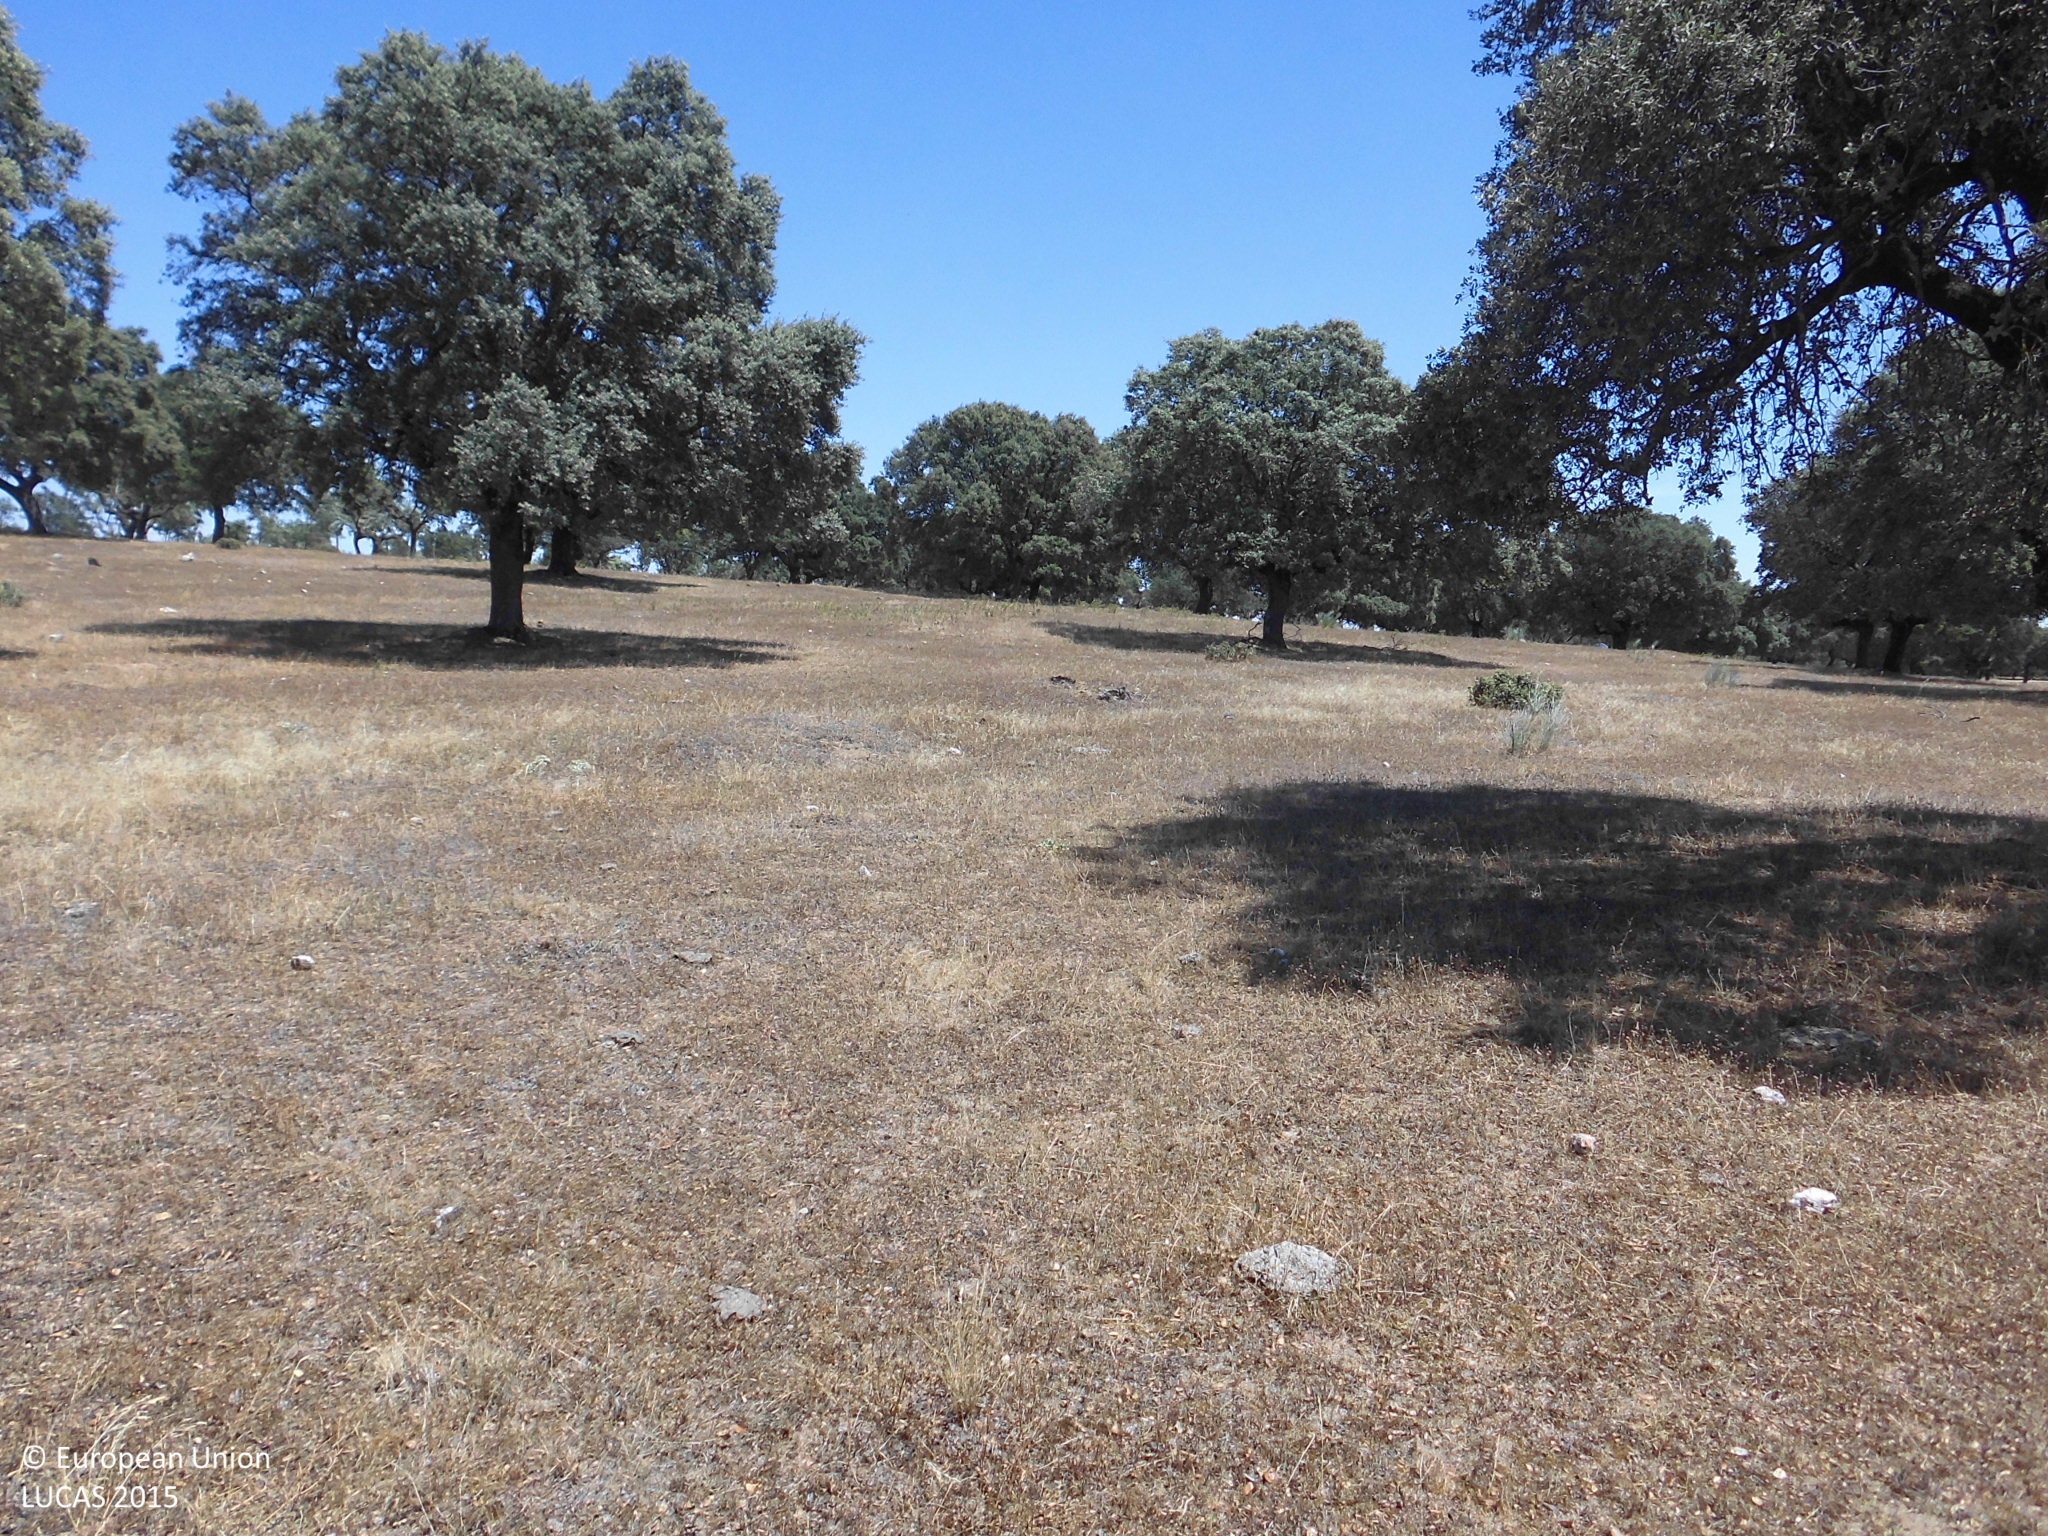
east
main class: Woodland
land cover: Broadleaved woodland
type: broadleaved evergreen forest
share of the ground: 10 - 25 %
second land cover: Grassland without tree/shrub cover
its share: > 75 %
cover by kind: herbaceous plants 80 %, broadleaved forest trees 20 %
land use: Forestry
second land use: Agriculture (excluding fallow land and kitchen gardens)
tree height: > 5 m
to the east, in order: Broadleaved woodland; Grassland without tree/shrub cover; Broadleaved woodland; Fences; Broadleaved woodland; Fences; Broadleaved woodland
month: June
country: ES
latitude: 39.9729
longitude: -6.1238
